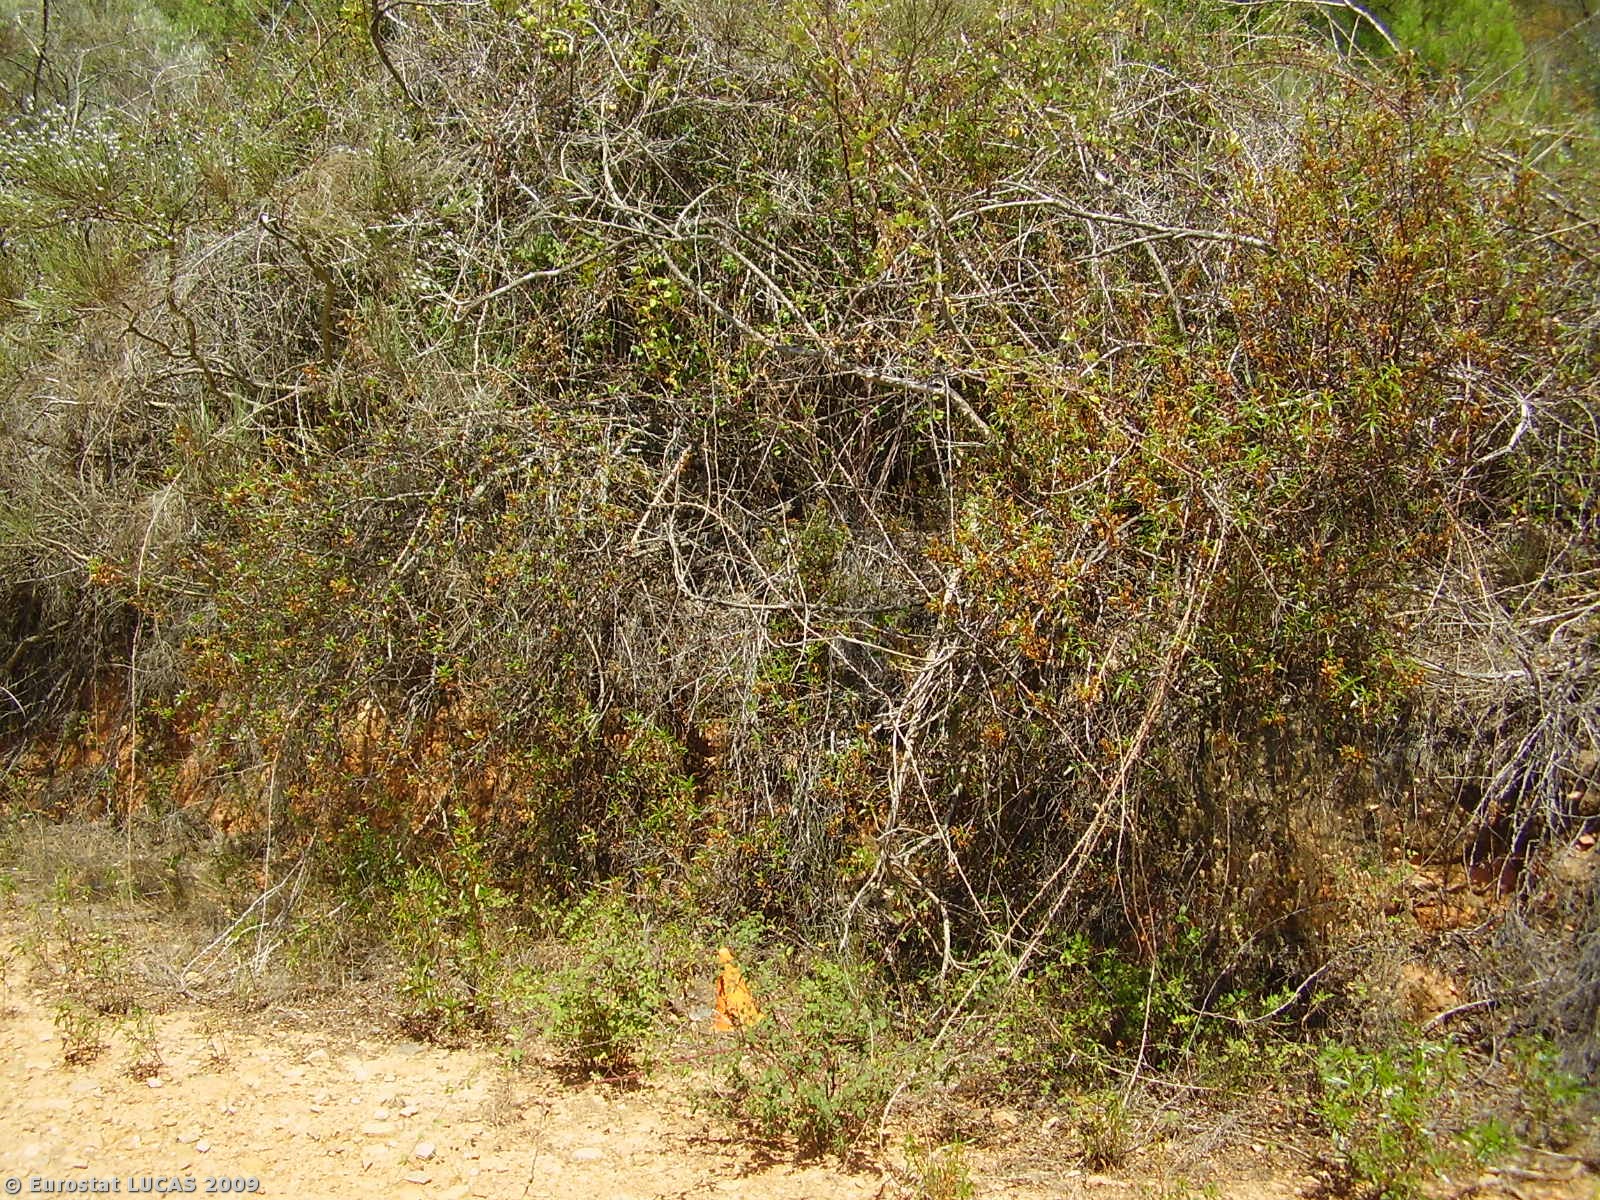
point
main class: Shrubland
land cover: Shrubland with sparse tree cover
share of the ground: 50 - 75 %
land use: Unused
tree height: > 5 m
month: July
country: PT
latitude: 41.4431
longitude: -7.3212
